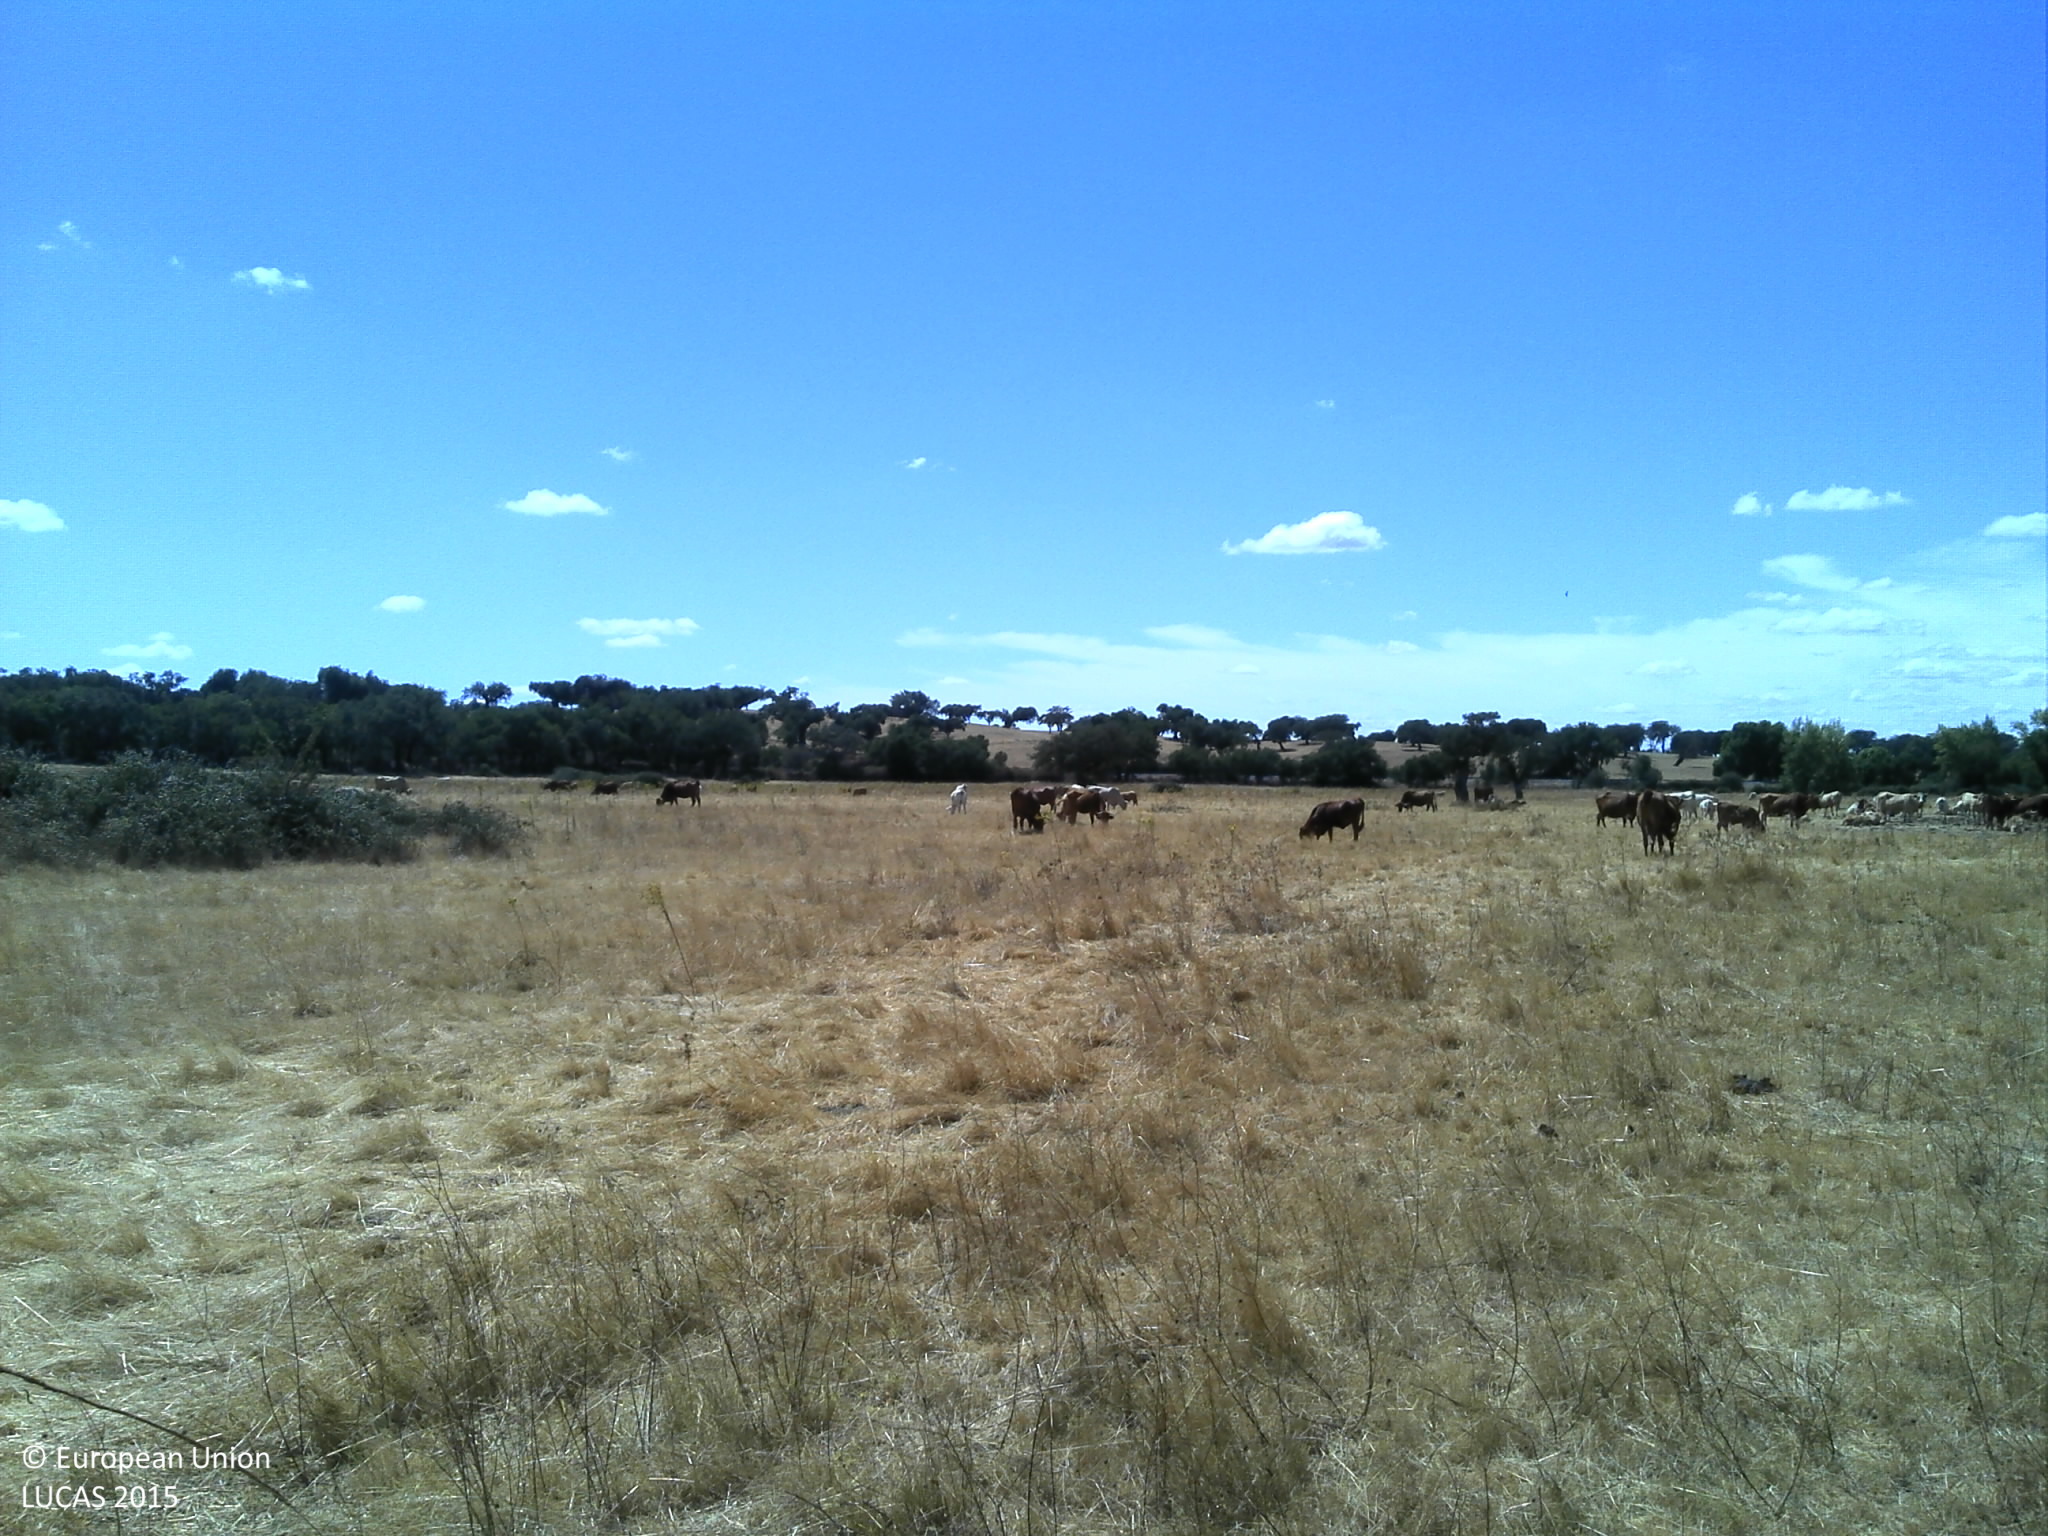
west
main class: Grassland
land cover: Grassland without tree/shrub cover
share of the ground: 50 - 75 %
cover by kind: herbaceous plants 60 %, unconsolidated bare surface 40 %
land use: Agriculture (excluding fallow land and kitchen gardens)
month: July
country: PT
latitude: 39.1899
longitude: -7.4411
